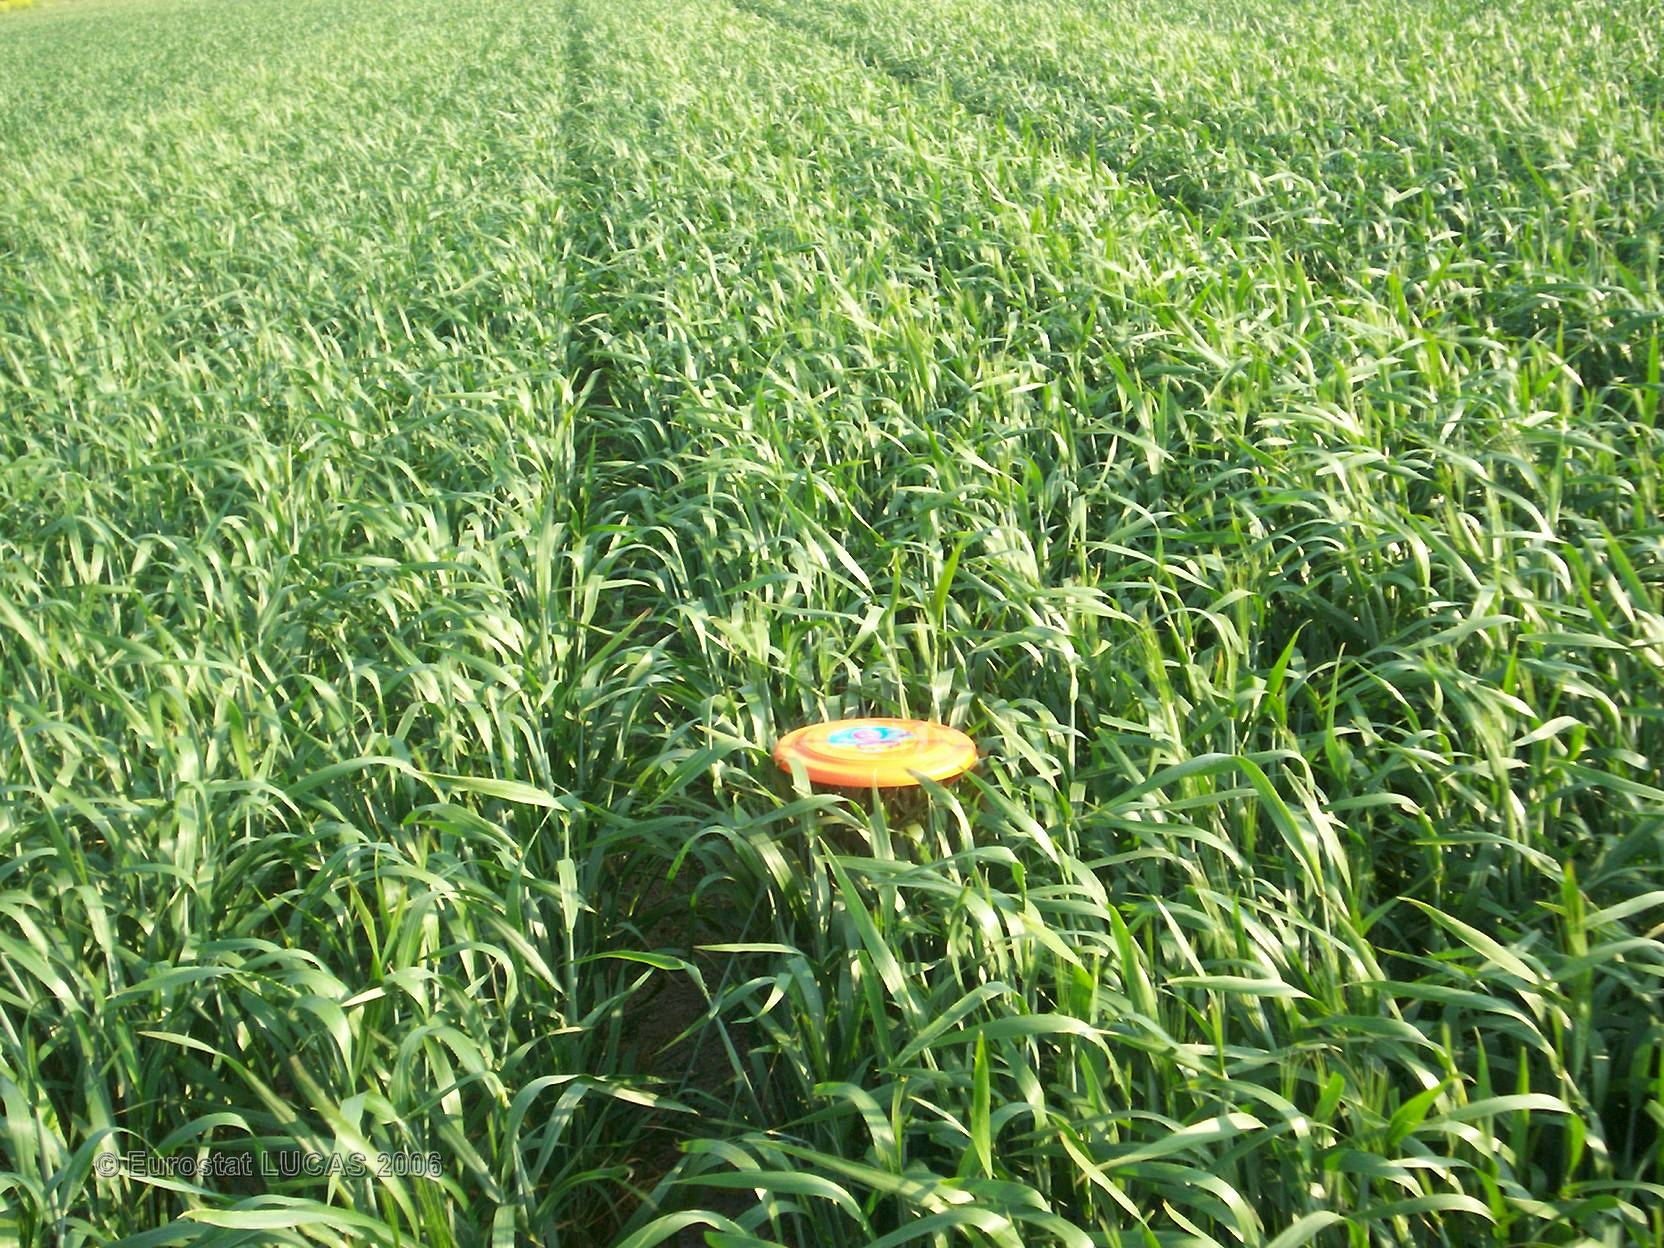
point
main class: Cropland
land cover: Durum wheat
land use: Agriculture (excluding fallow land and kitchen gardens)
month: May
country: FR
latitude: 44.0626
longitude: 4.9023
